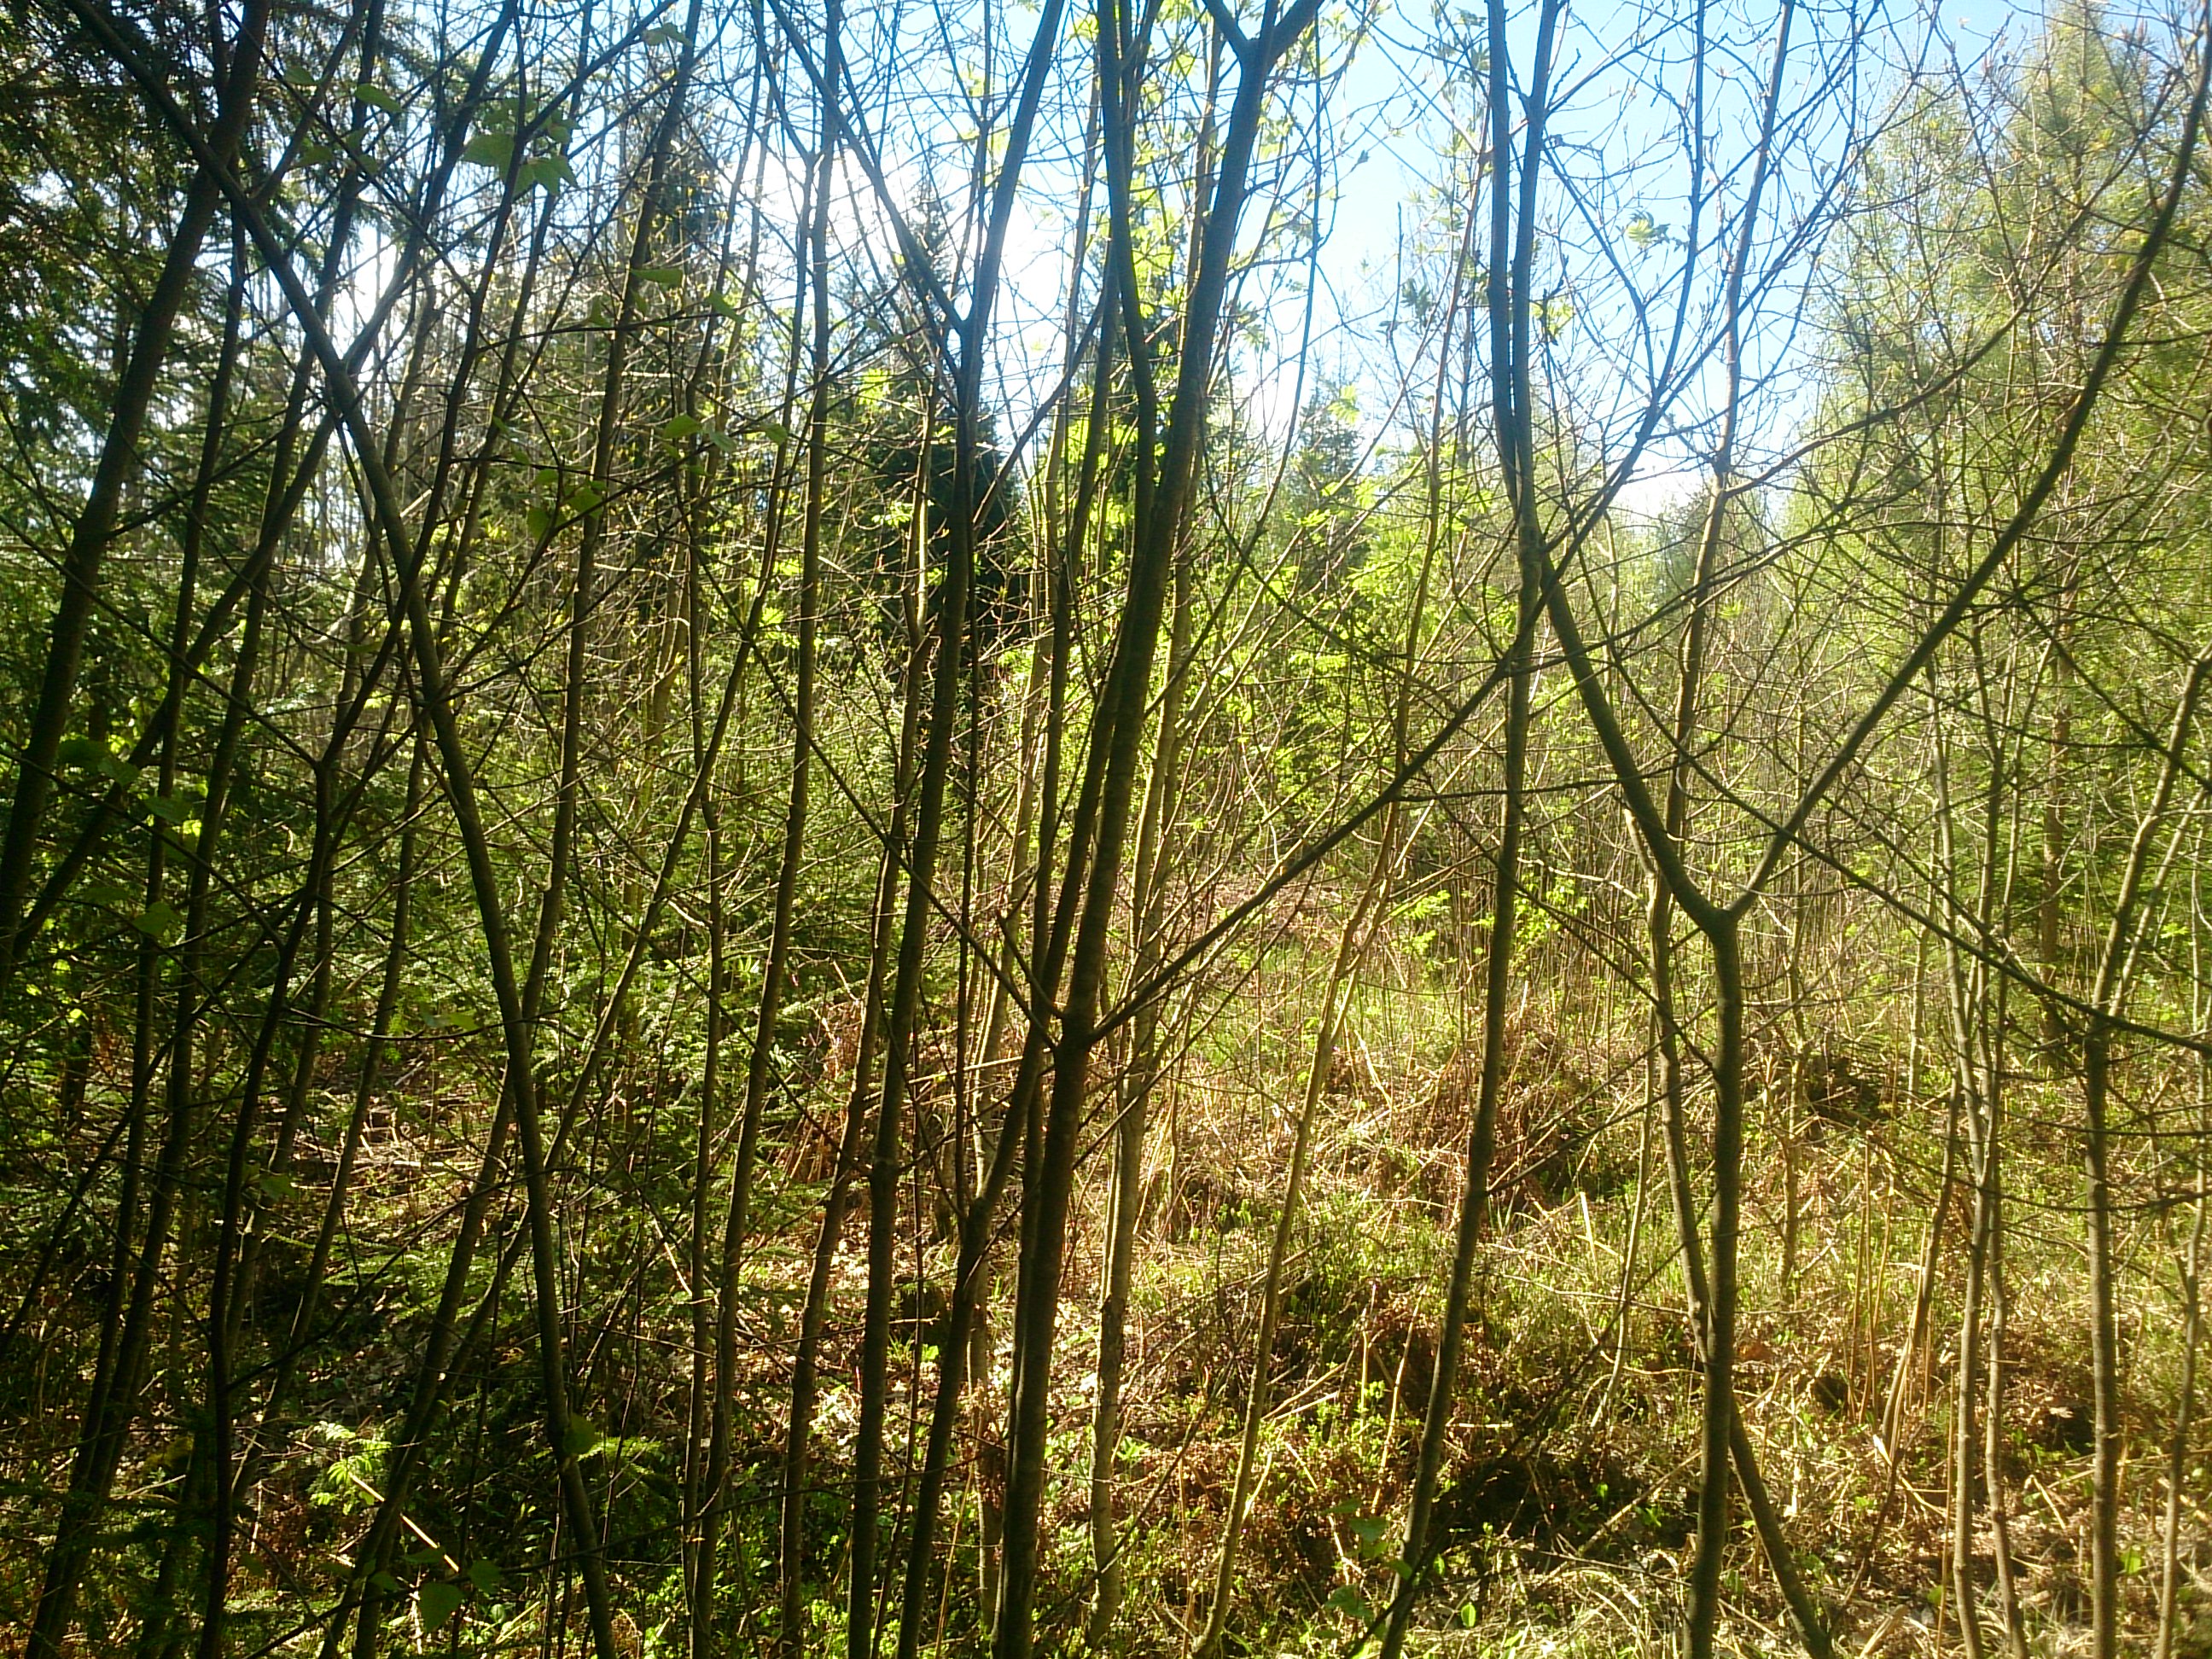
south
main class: Woodland
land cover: Spruce dominated mixed woodland
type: hemiboreal forest and nemoral coniferous forest and mixed broadleaved-coniferous forest
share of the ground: > 75 %
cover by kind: coniferous forest trees 40 %, broadleaved forest trees 40 %, herbaceous plants 10 %, lichens and mosses 10 %
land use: Forestry
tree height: > 5 m
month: May
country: LV
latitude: 56.7144
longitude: 24.3212
